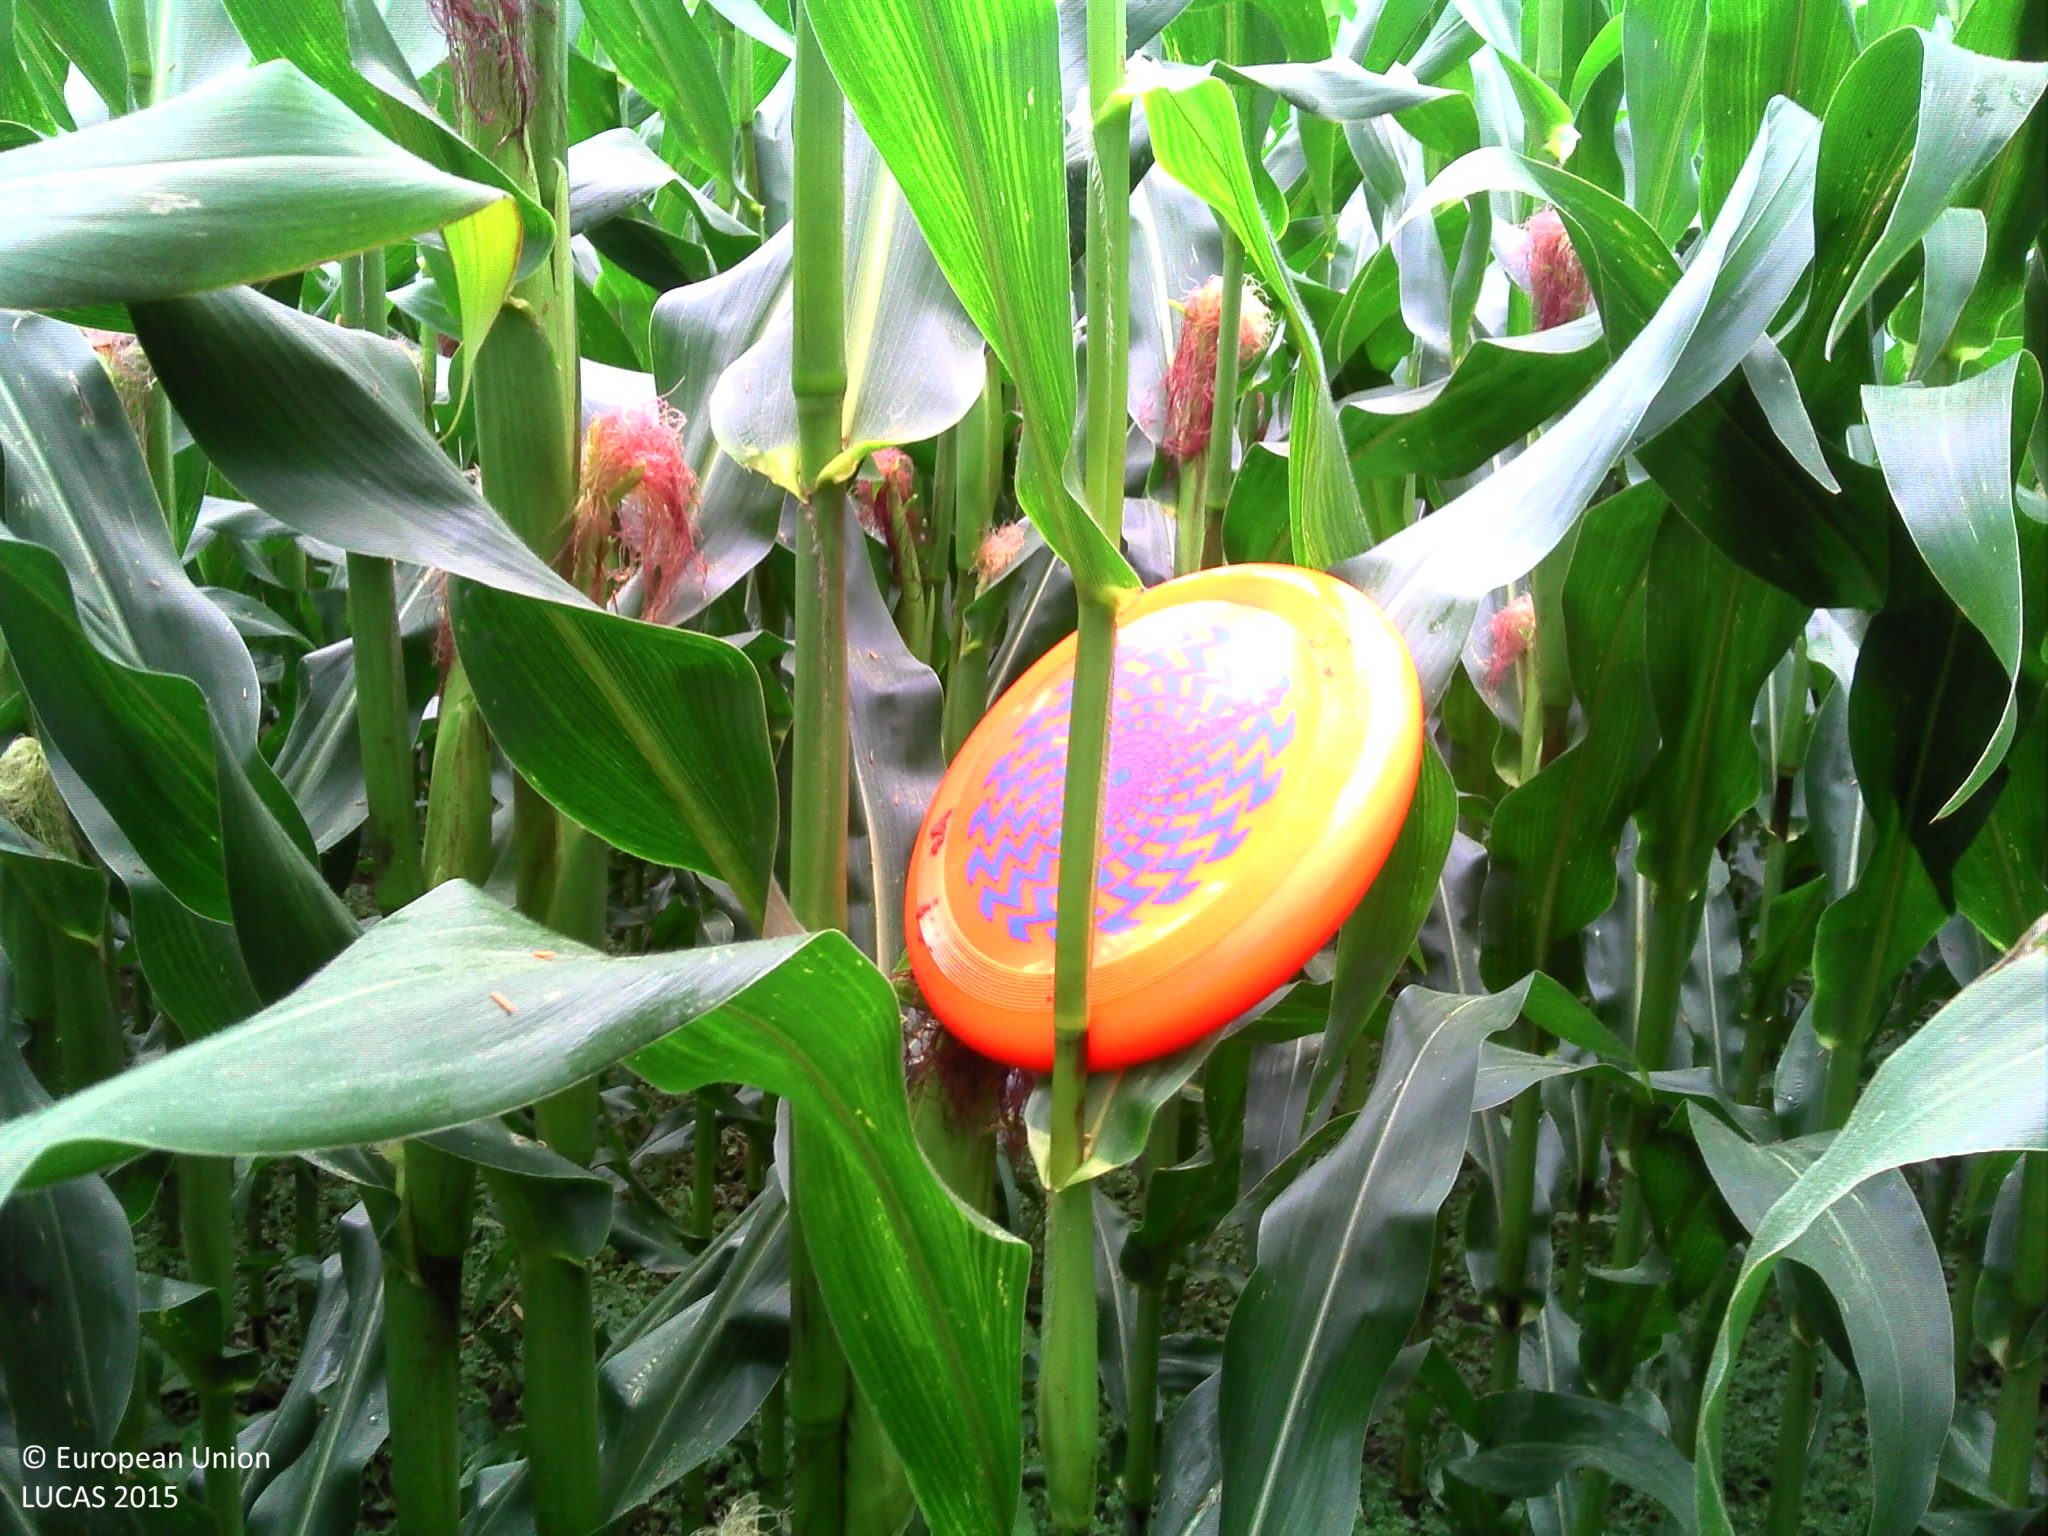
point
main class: Cropland
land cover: Maize
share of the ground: > 75 %
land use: Agriculture (excluding fallow land and kitchen gardens)
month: August
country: FR
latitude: 48.8204
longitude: -3.2736
